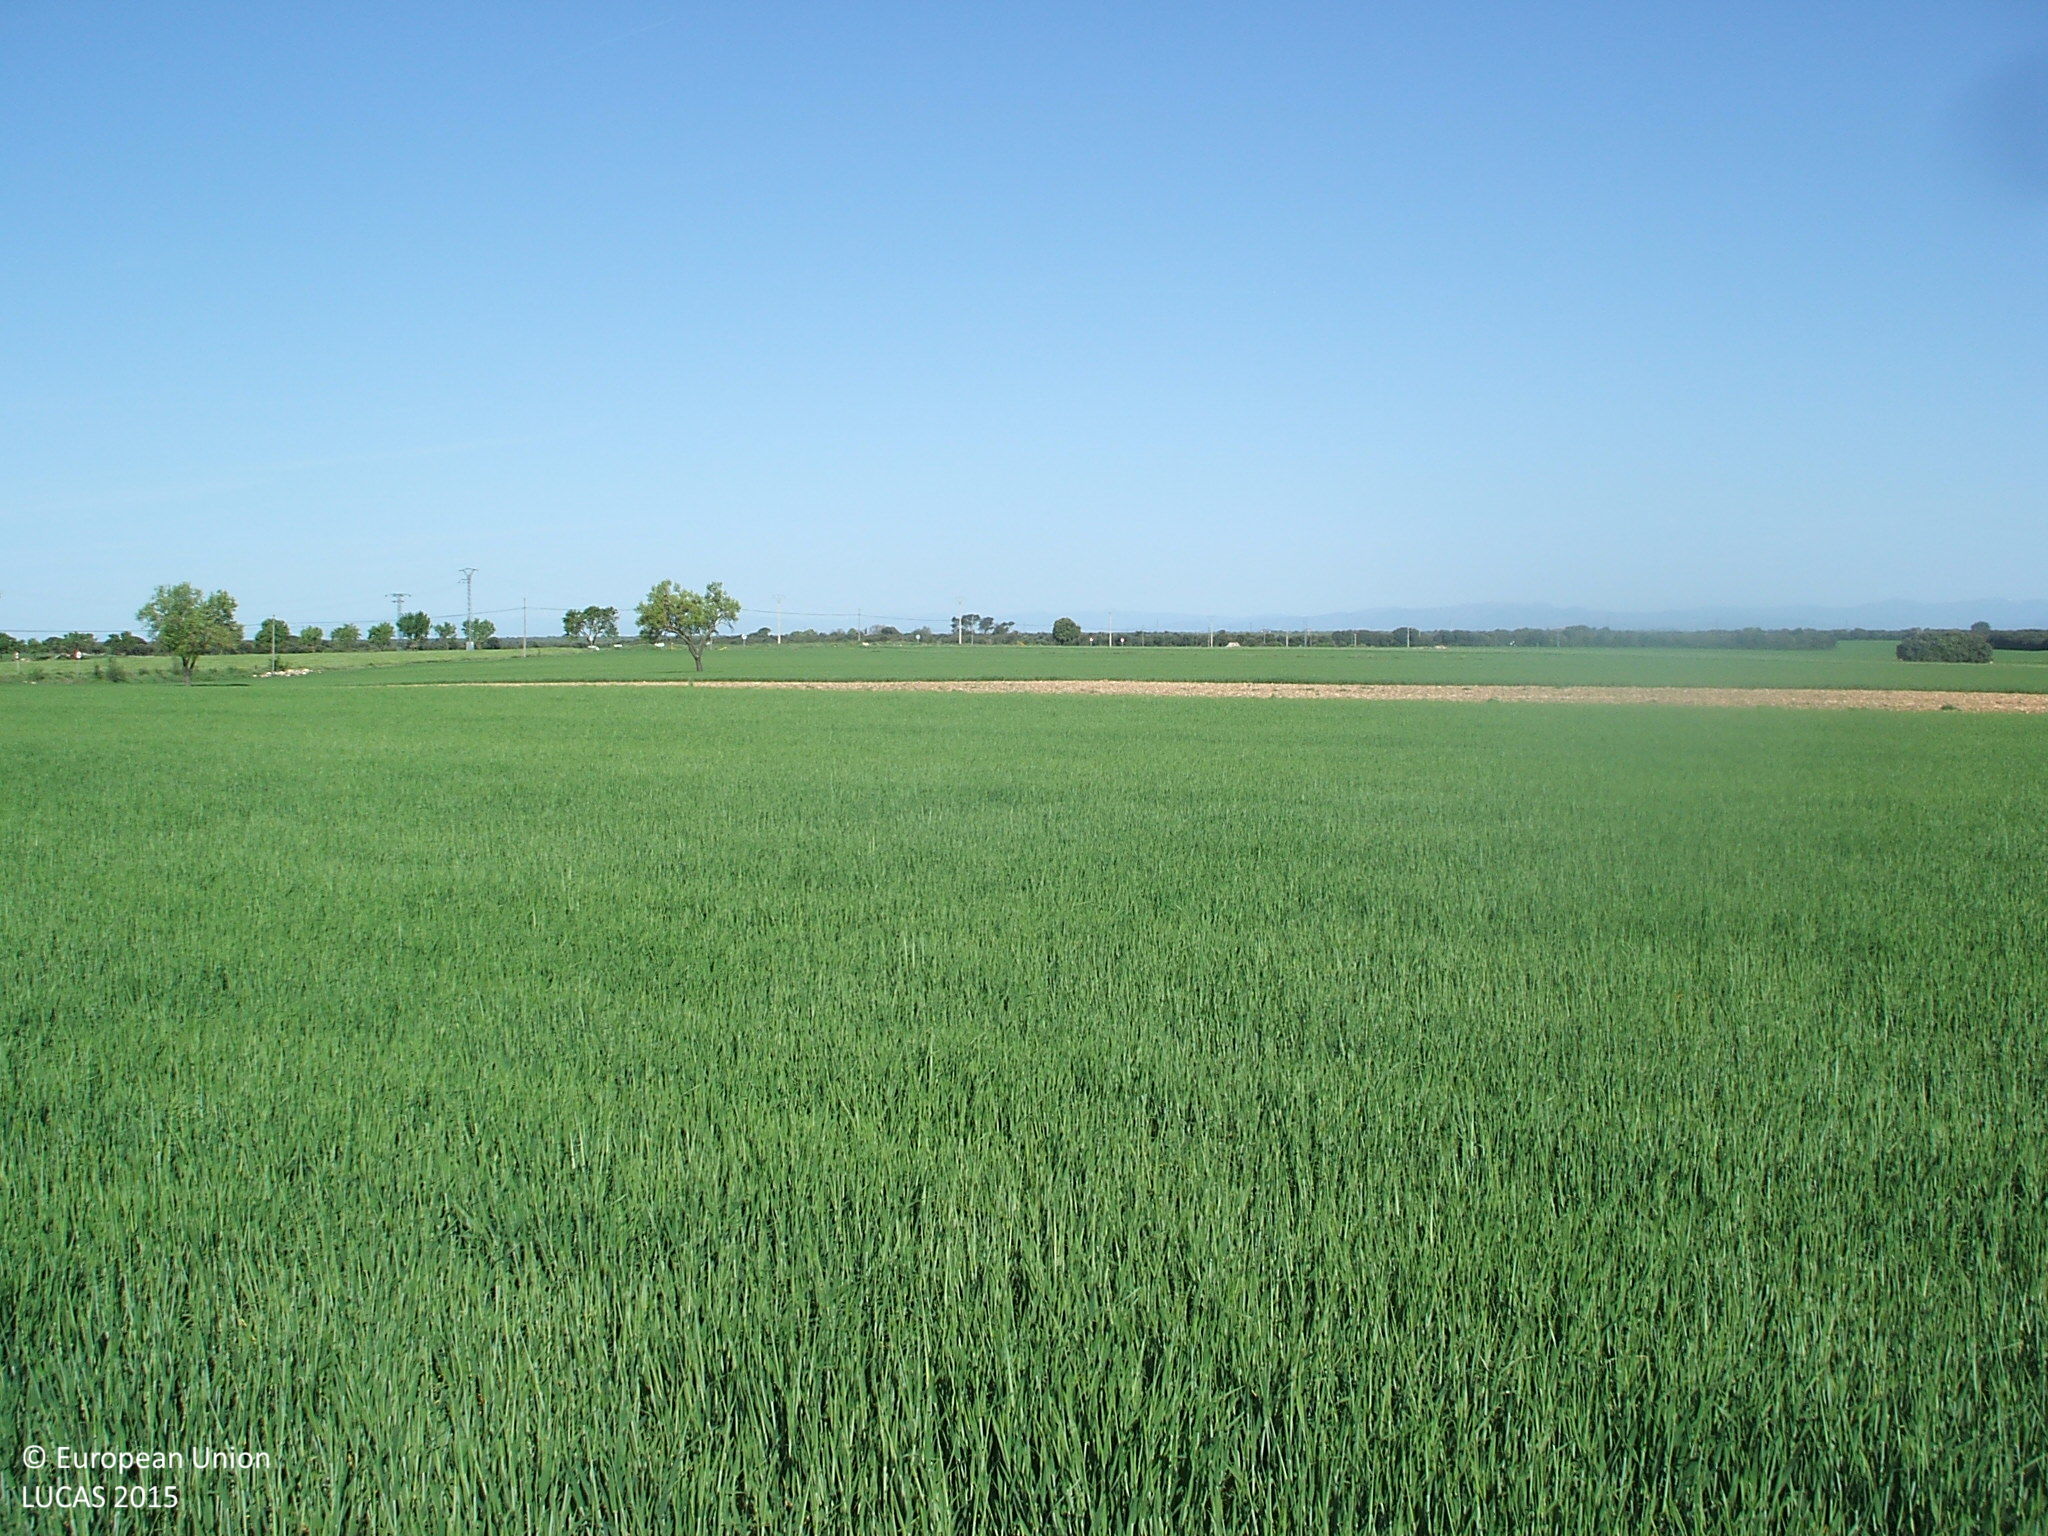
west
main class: Cropland
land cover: Barley
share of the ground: > 75 %
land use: Agriculture (excluding fallow land and kitchen gardens)
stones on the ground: > 50 %
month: May
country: ES
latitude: 40.7673
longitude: -2.8856
